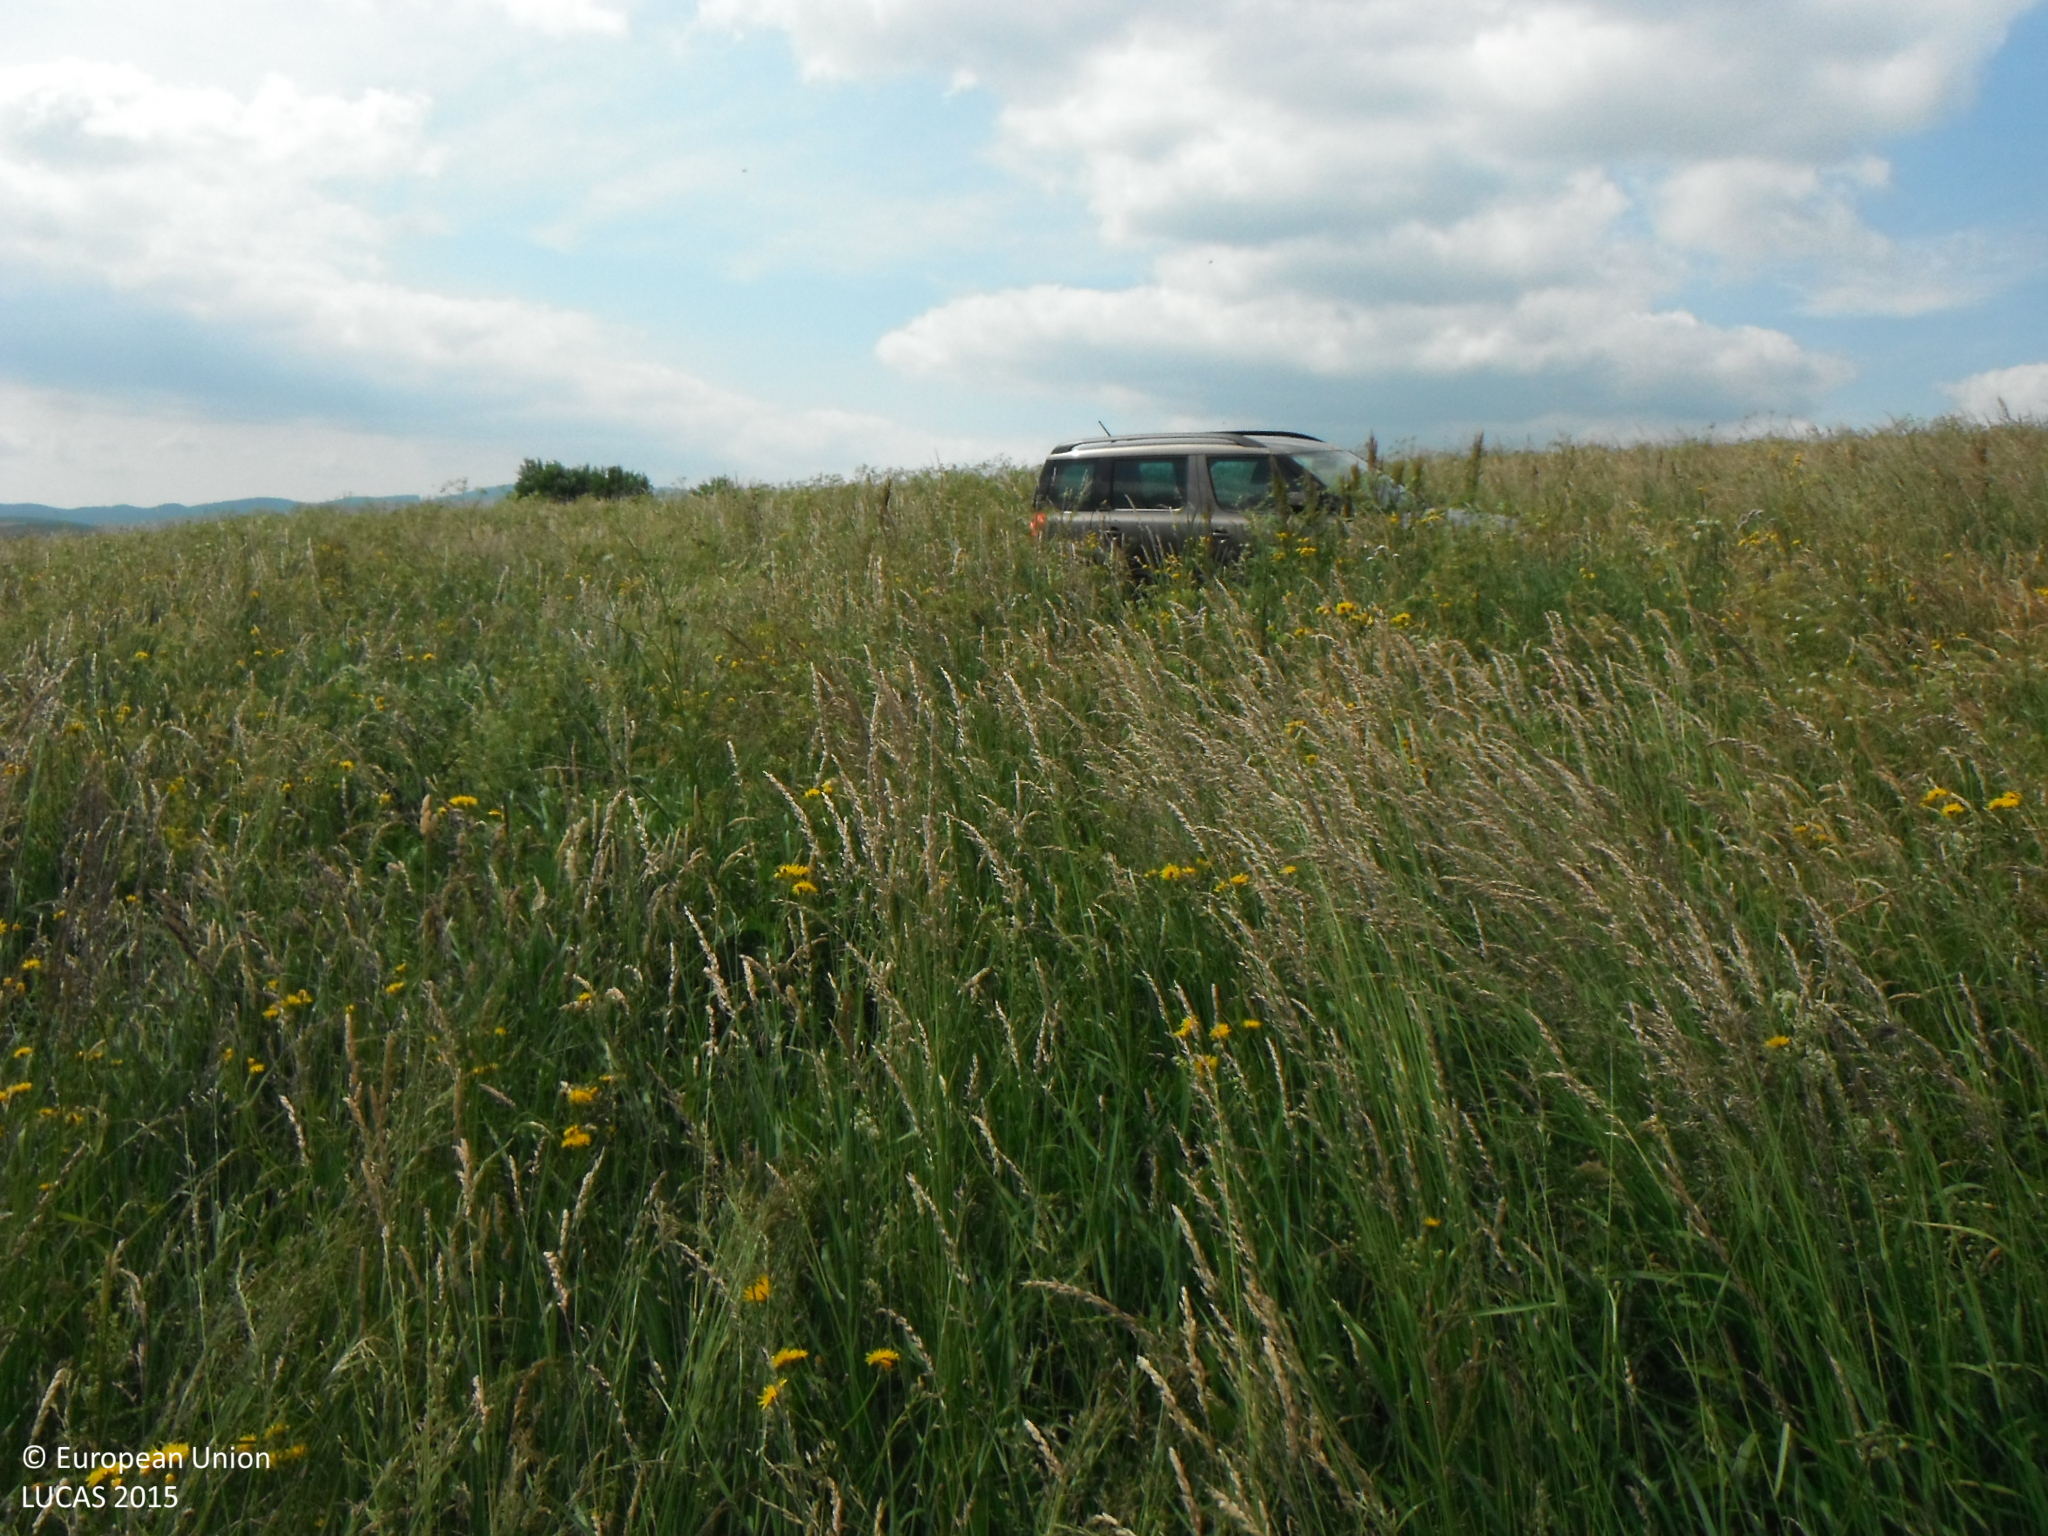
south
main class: Grassland
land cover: Grassland without tree/shrub cover
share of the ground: > 75 %
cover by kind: herbaceous plants 100 %
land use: Agriculture (excluding fallow land and kitchen gardens)
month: June
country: SK
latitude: 48.9977
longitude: 20.9901
